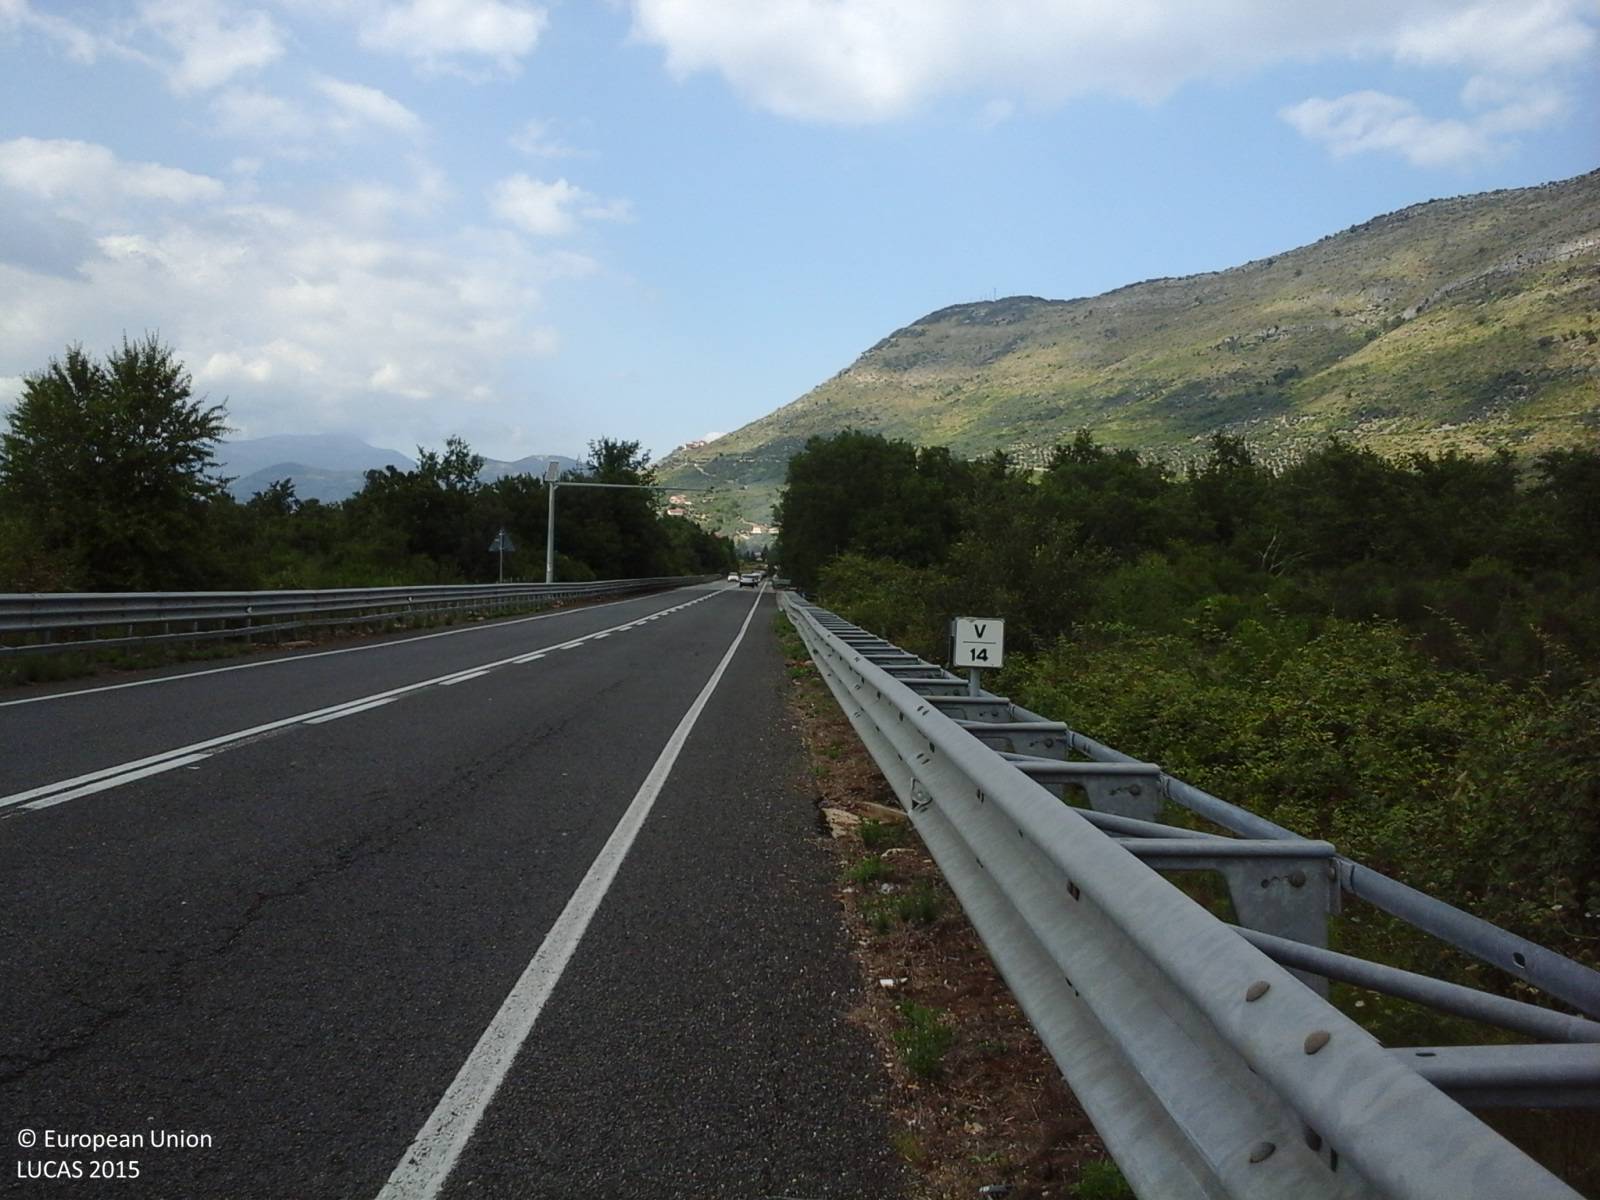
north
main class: Grassland
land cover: Grassland with sparse tree/shrub cover
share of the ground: > 75 %
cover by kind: herbaceous plants 85 %, shrubs 10 %, broadleaved forest trees 5 %
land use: Abandoned areas
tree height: < 5 m
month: August
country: IT
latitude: 41.4460
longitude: 13.2071
